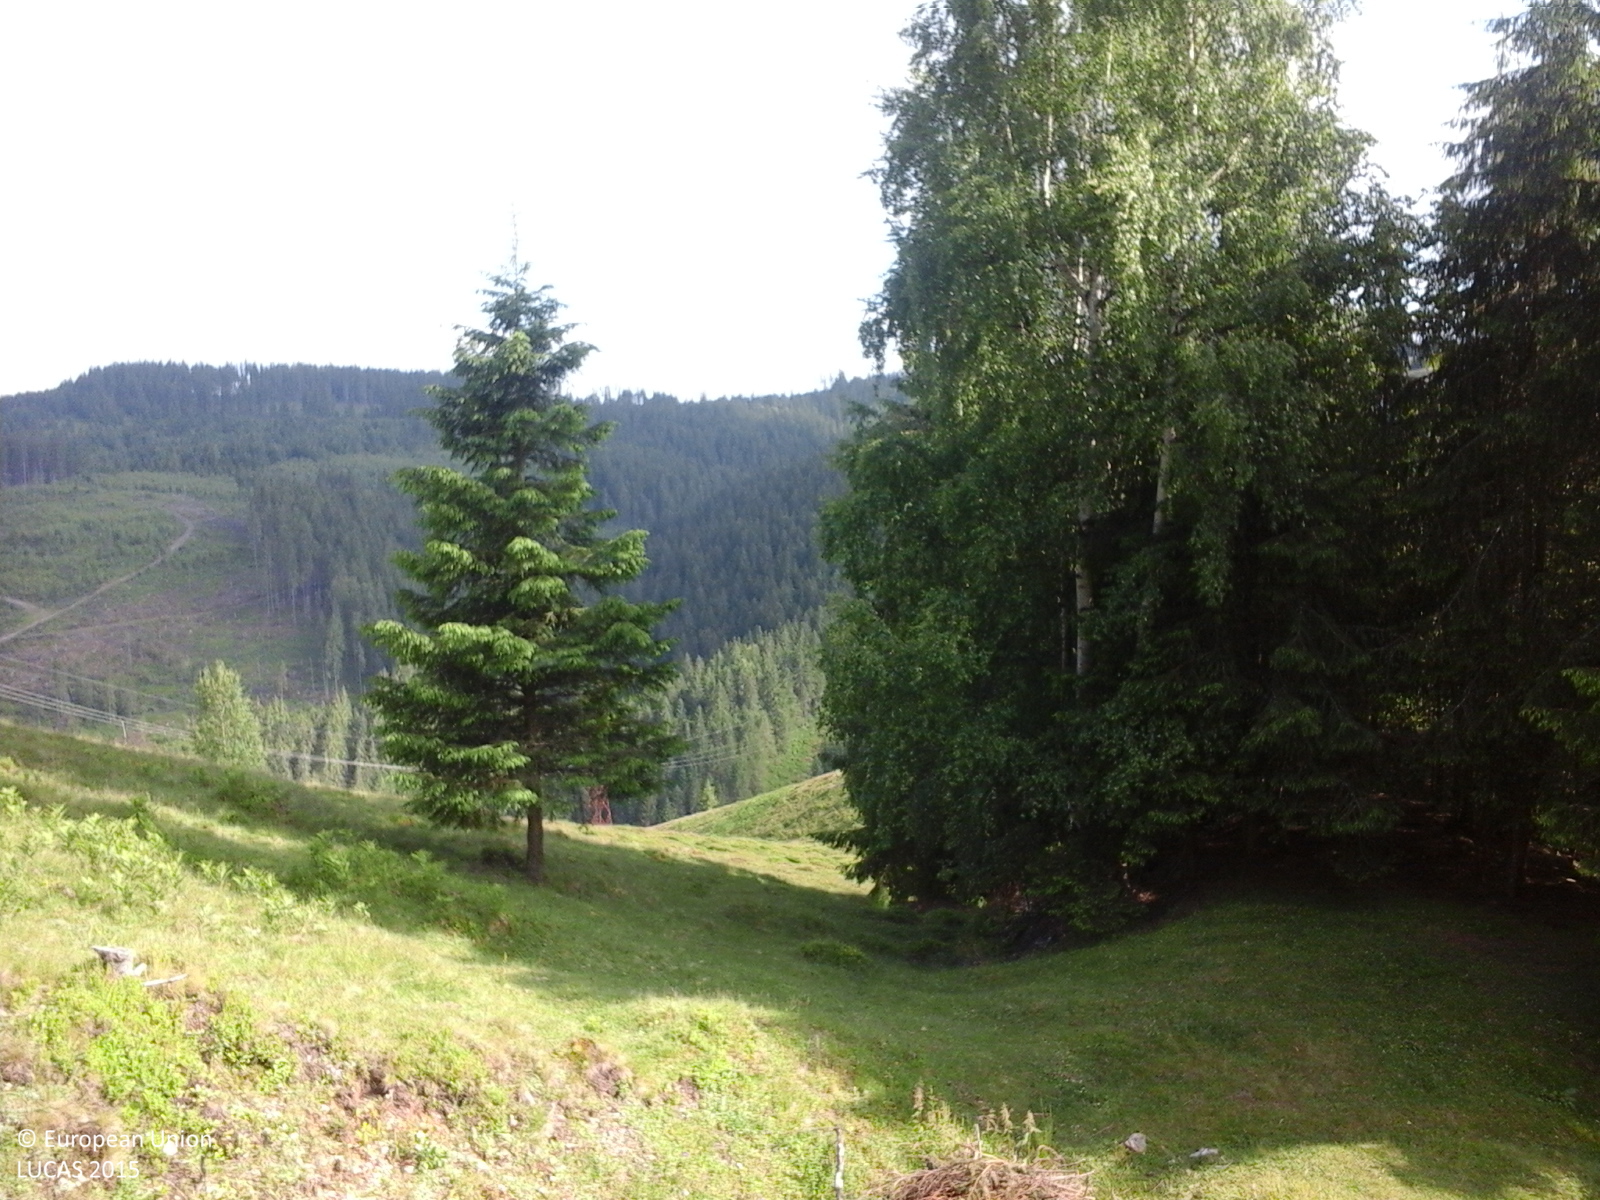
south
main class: Grassland
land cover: Grassland without tree/shrub cover
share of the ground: > 75 %
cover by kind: herbaceous plants 100 %
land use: Agriculture (excluding fallow land and kitchen gardens)
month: June
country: RO
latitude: 47.4901
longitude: 25.3359
